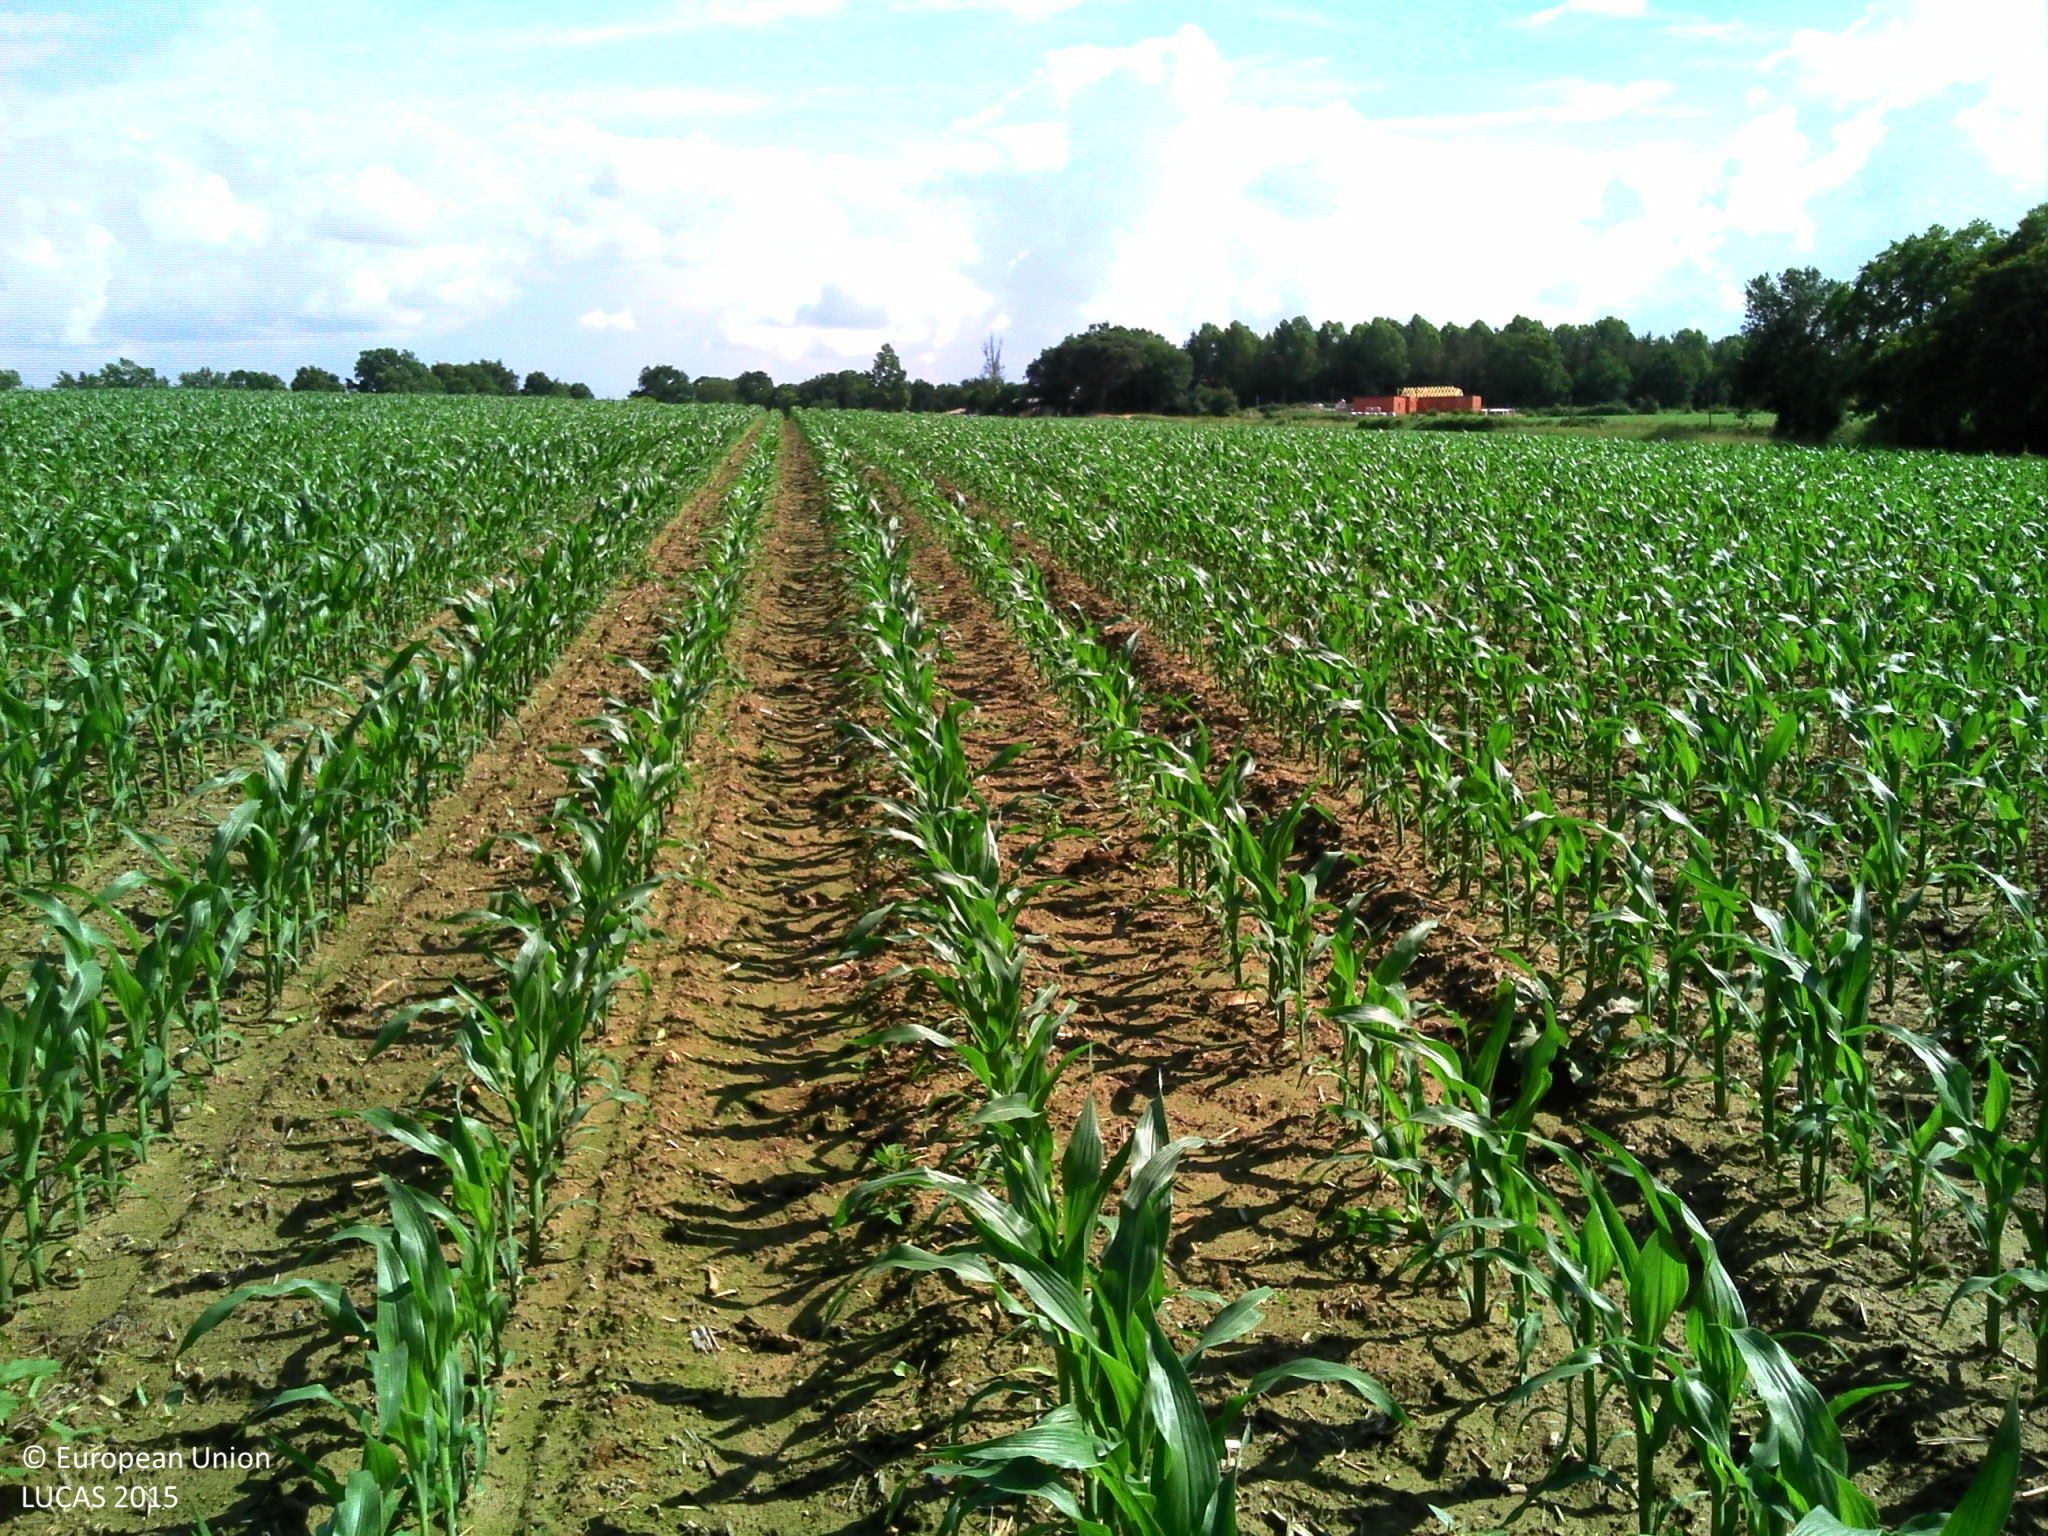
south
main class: Cropland
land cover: Maize
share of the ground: 25 - 50 %
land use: Agriculture (excluding fallow land and kitchen gardens)
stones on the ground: < 10 %
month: June
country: FR
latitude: 43.8064
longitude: -0.2395
